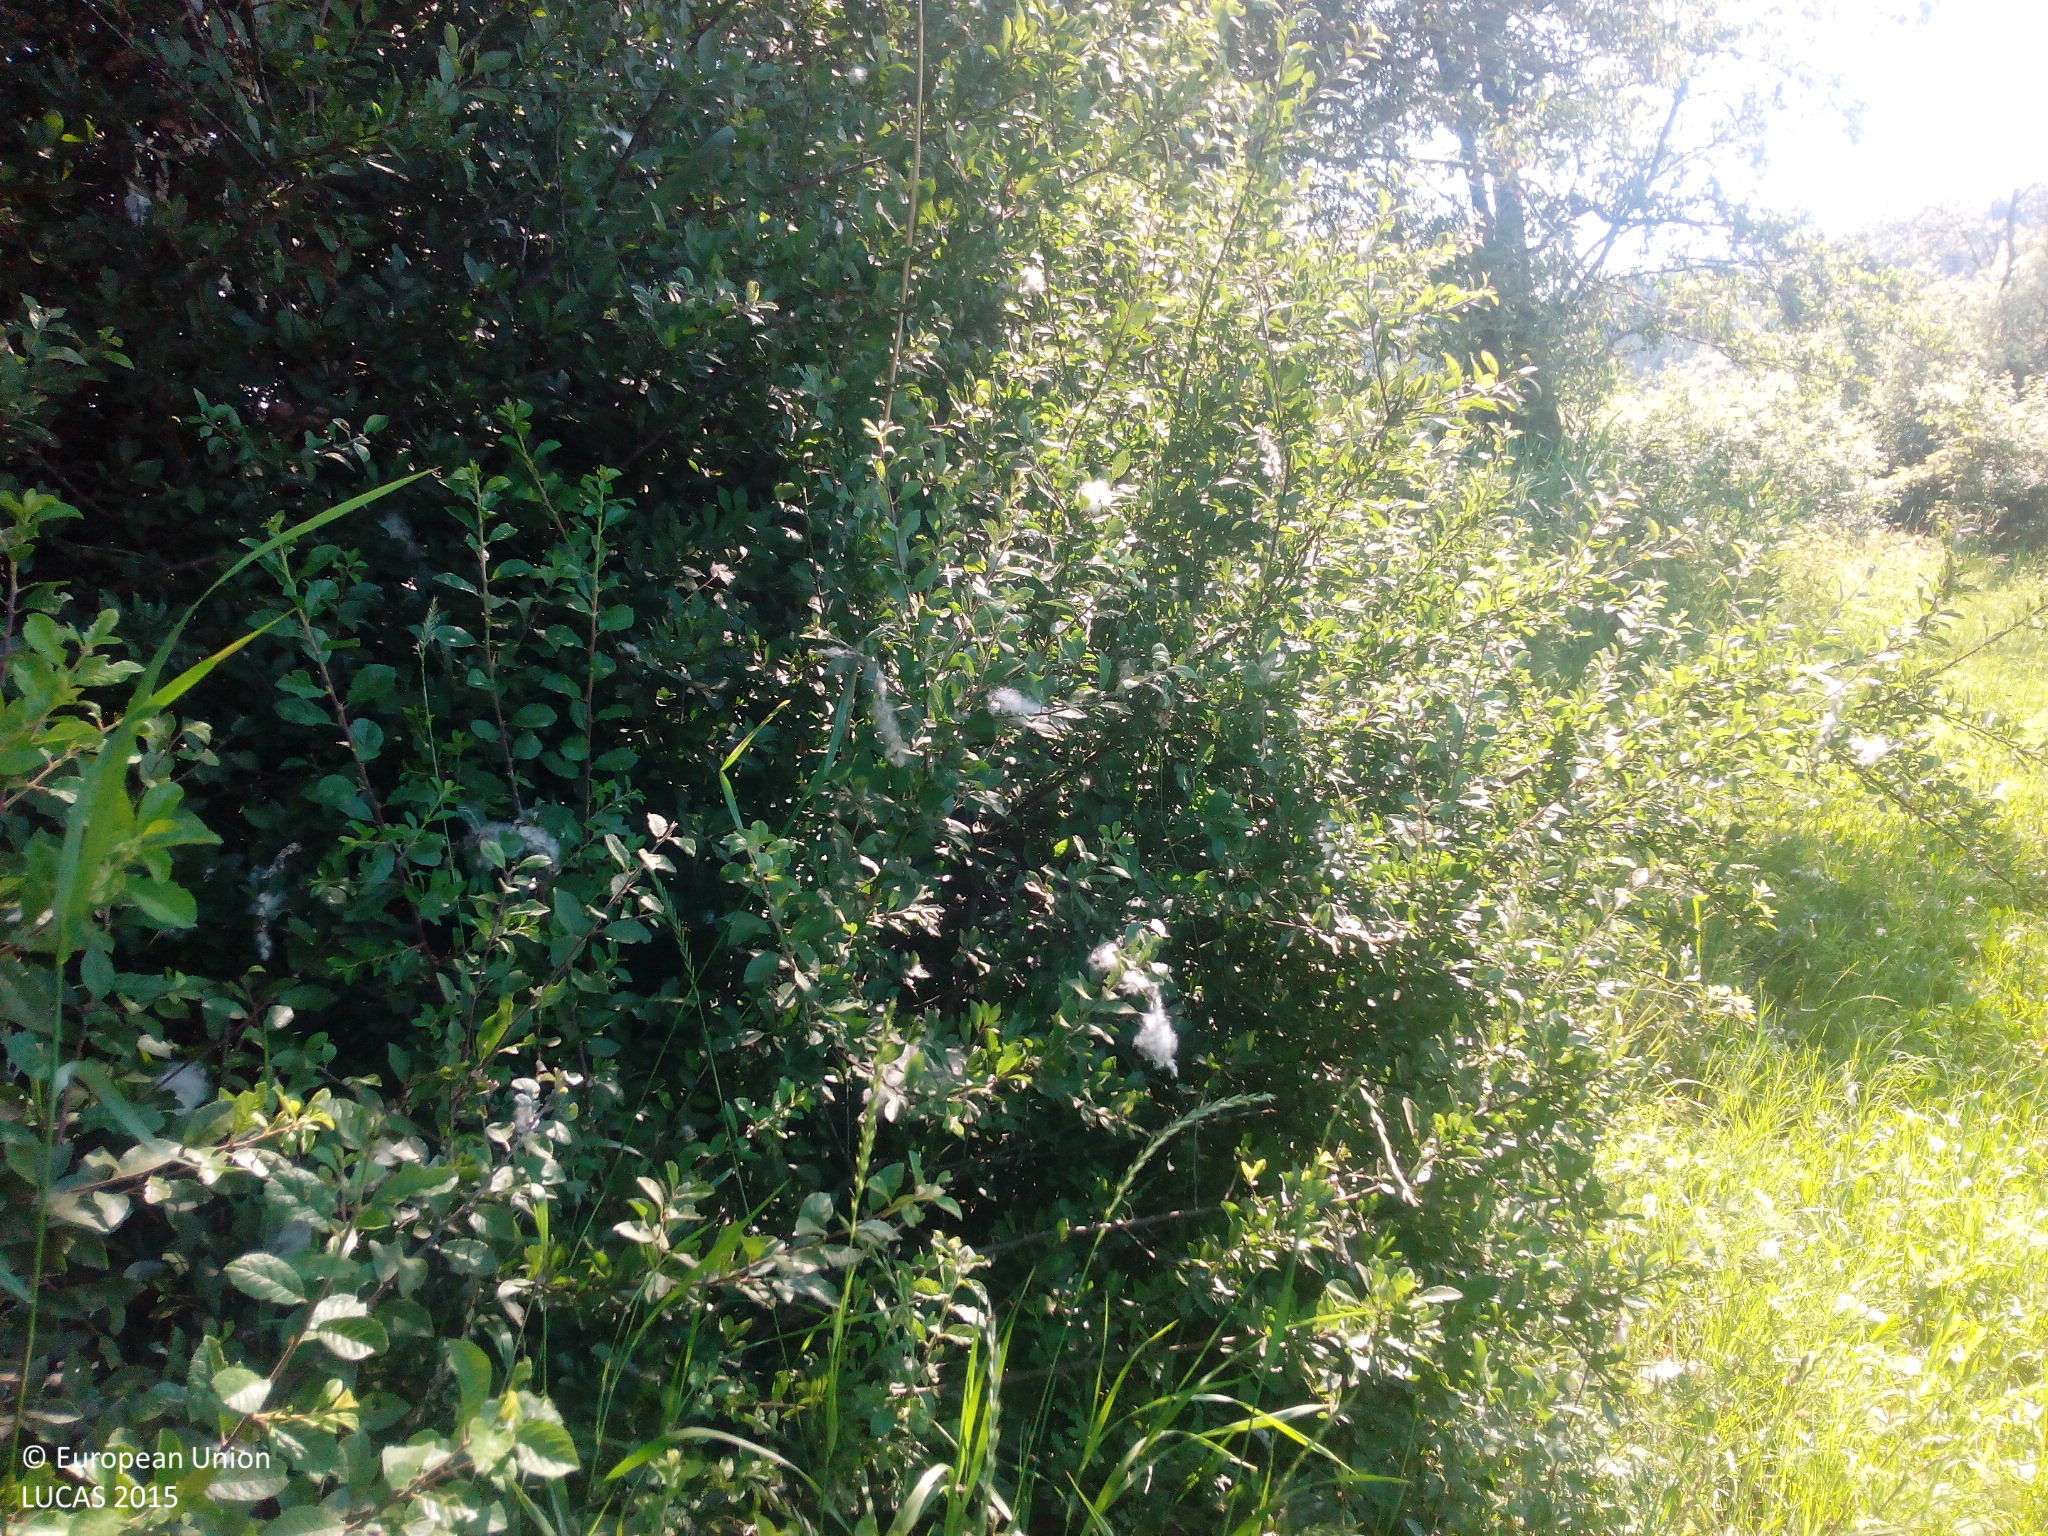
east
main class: Woodland
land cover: Broadleaved woodland
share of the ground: > 75 %
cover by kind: broadleaved forest trees 80 %, shrubs 20 %
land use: Semi-natural and natural areas not in use
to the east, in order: Broadleaved woodland; Rivers and streams; Broadleaved woodland; Grassland without tree/shrub cover; Broadleaved woodland; Rivers and streams; Broadleaved woodland; Grassland without tree/shrub cover; Broadleaved woodland; Rivers and streams; Broadleaved woodland; Shruby margins
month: July
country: DE
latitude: 50.2009
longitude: 10.5462
